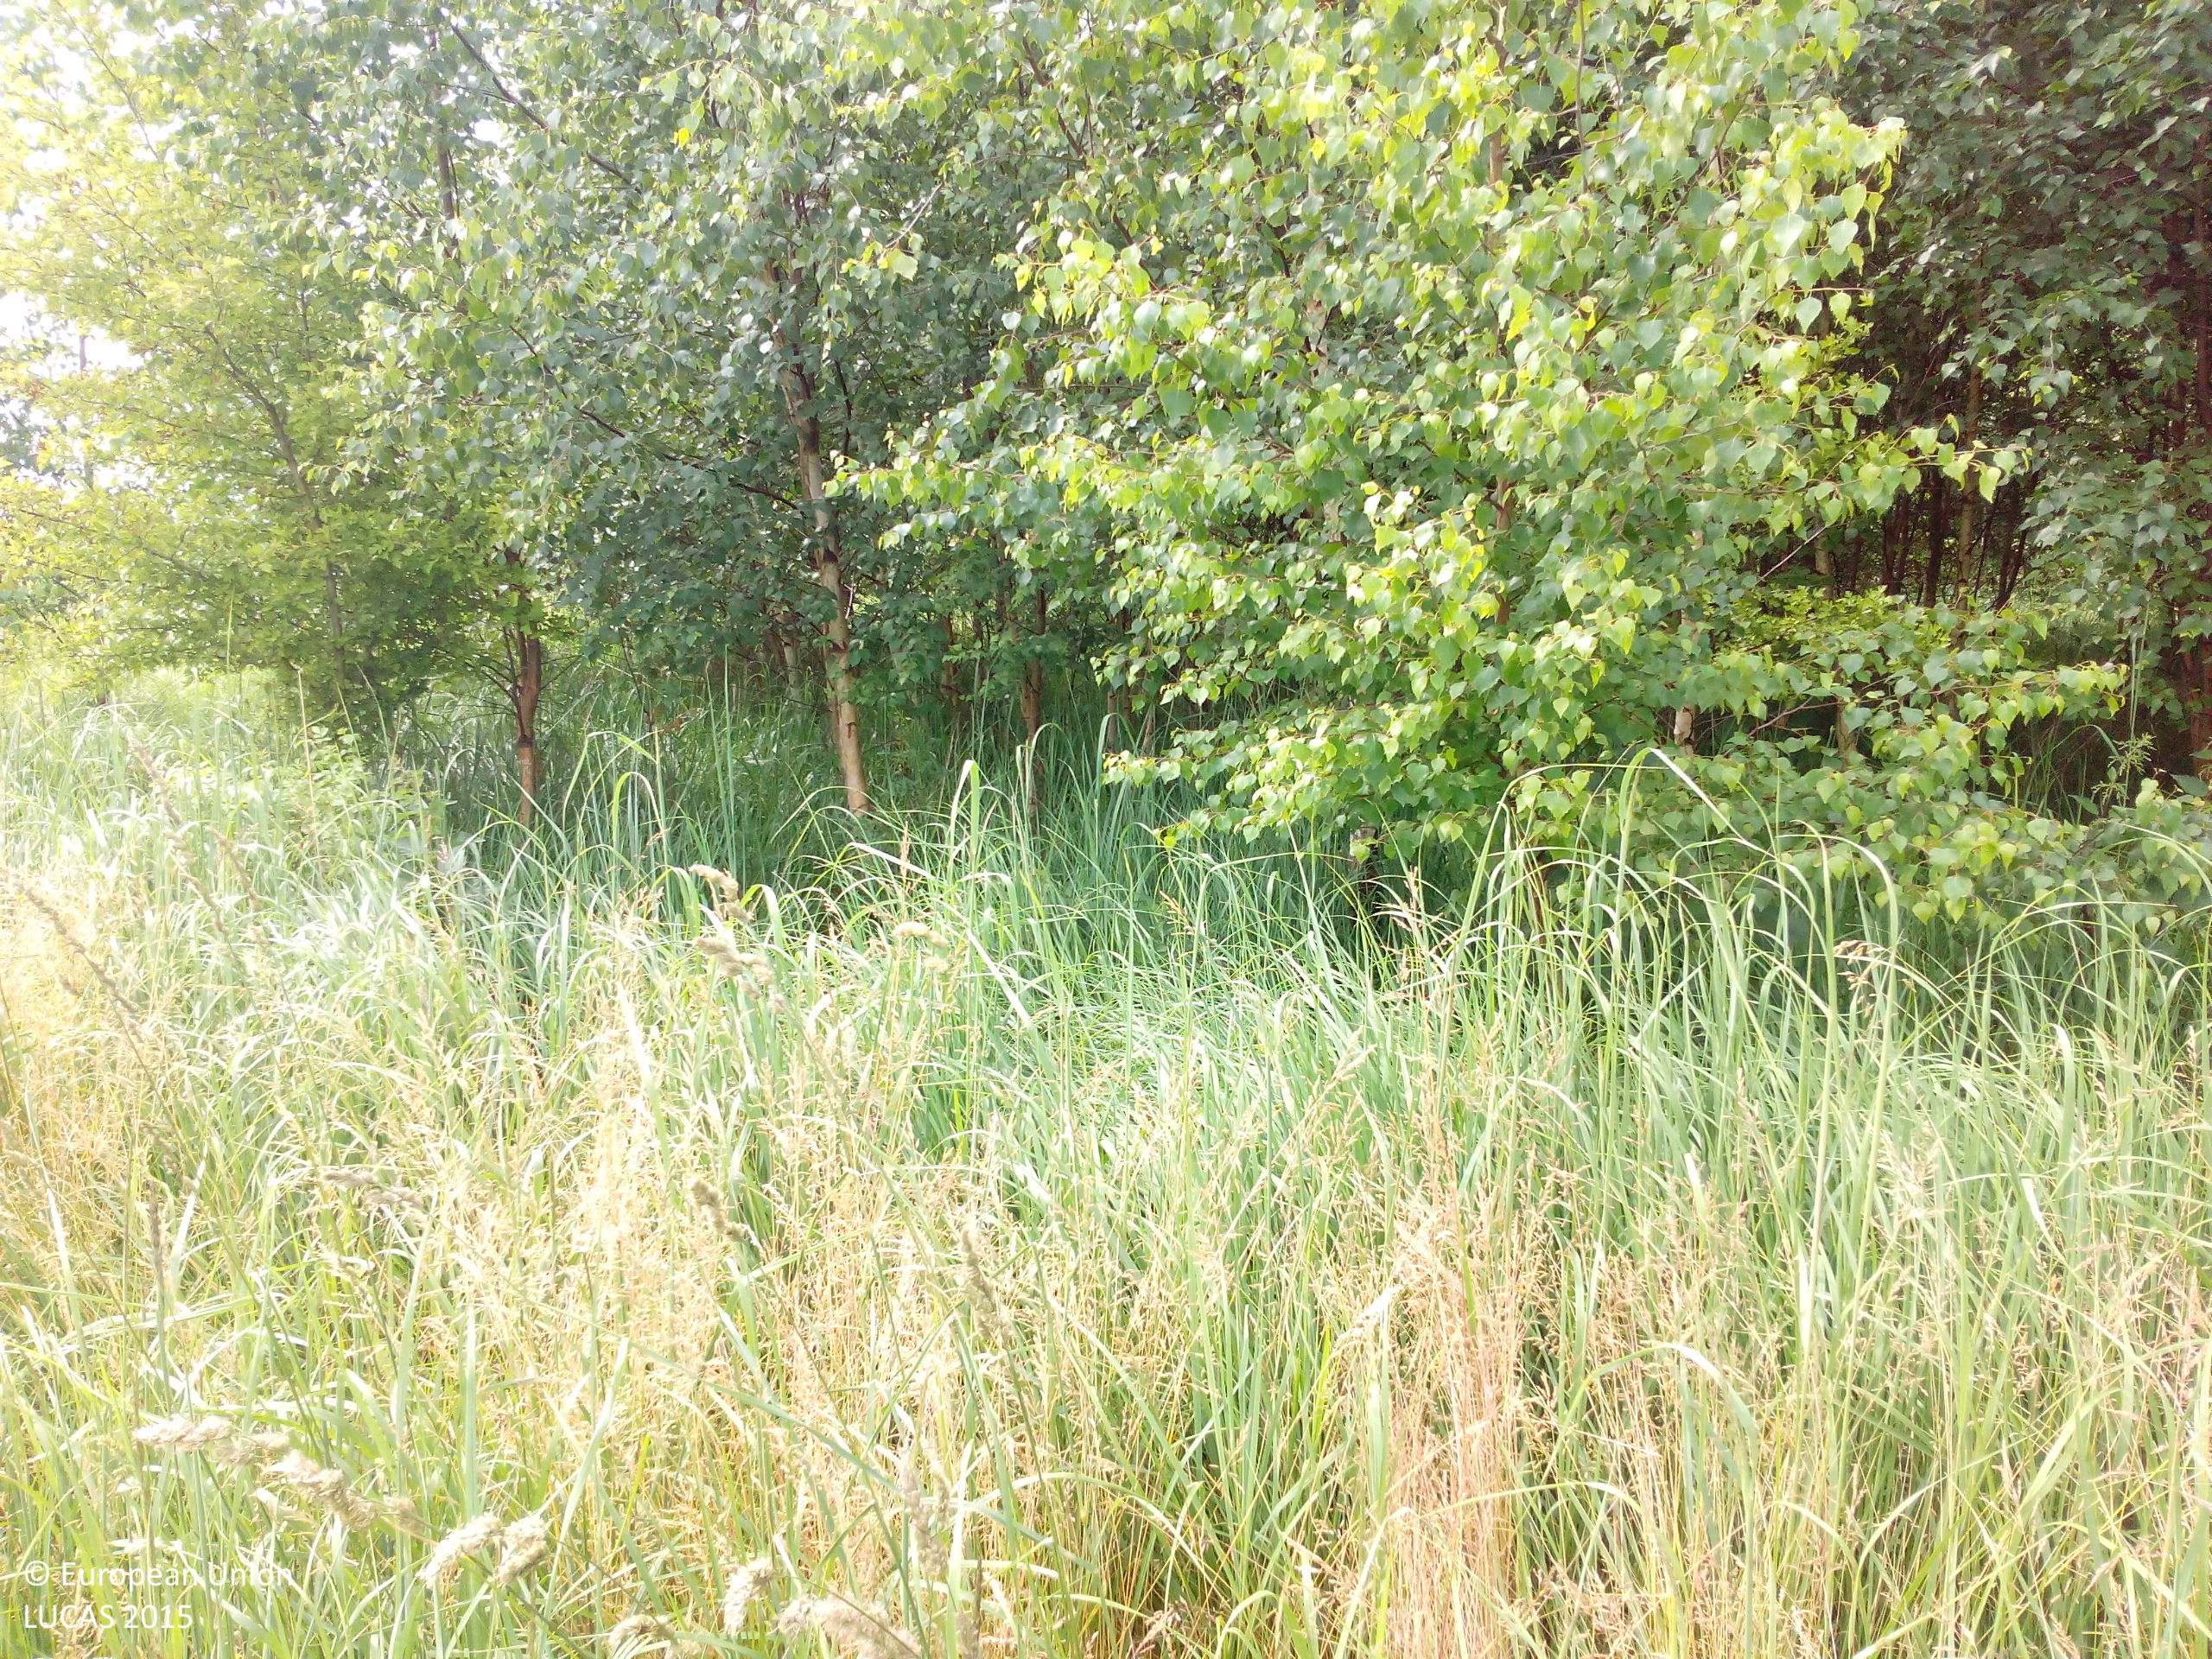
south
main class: Woodland
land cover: Broadleaved woodland
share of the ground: > 75 %
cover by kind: broadleaved forest trees 100 %
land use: Forestry
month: June
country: DE
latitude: 52.2103
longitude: 11.1265
